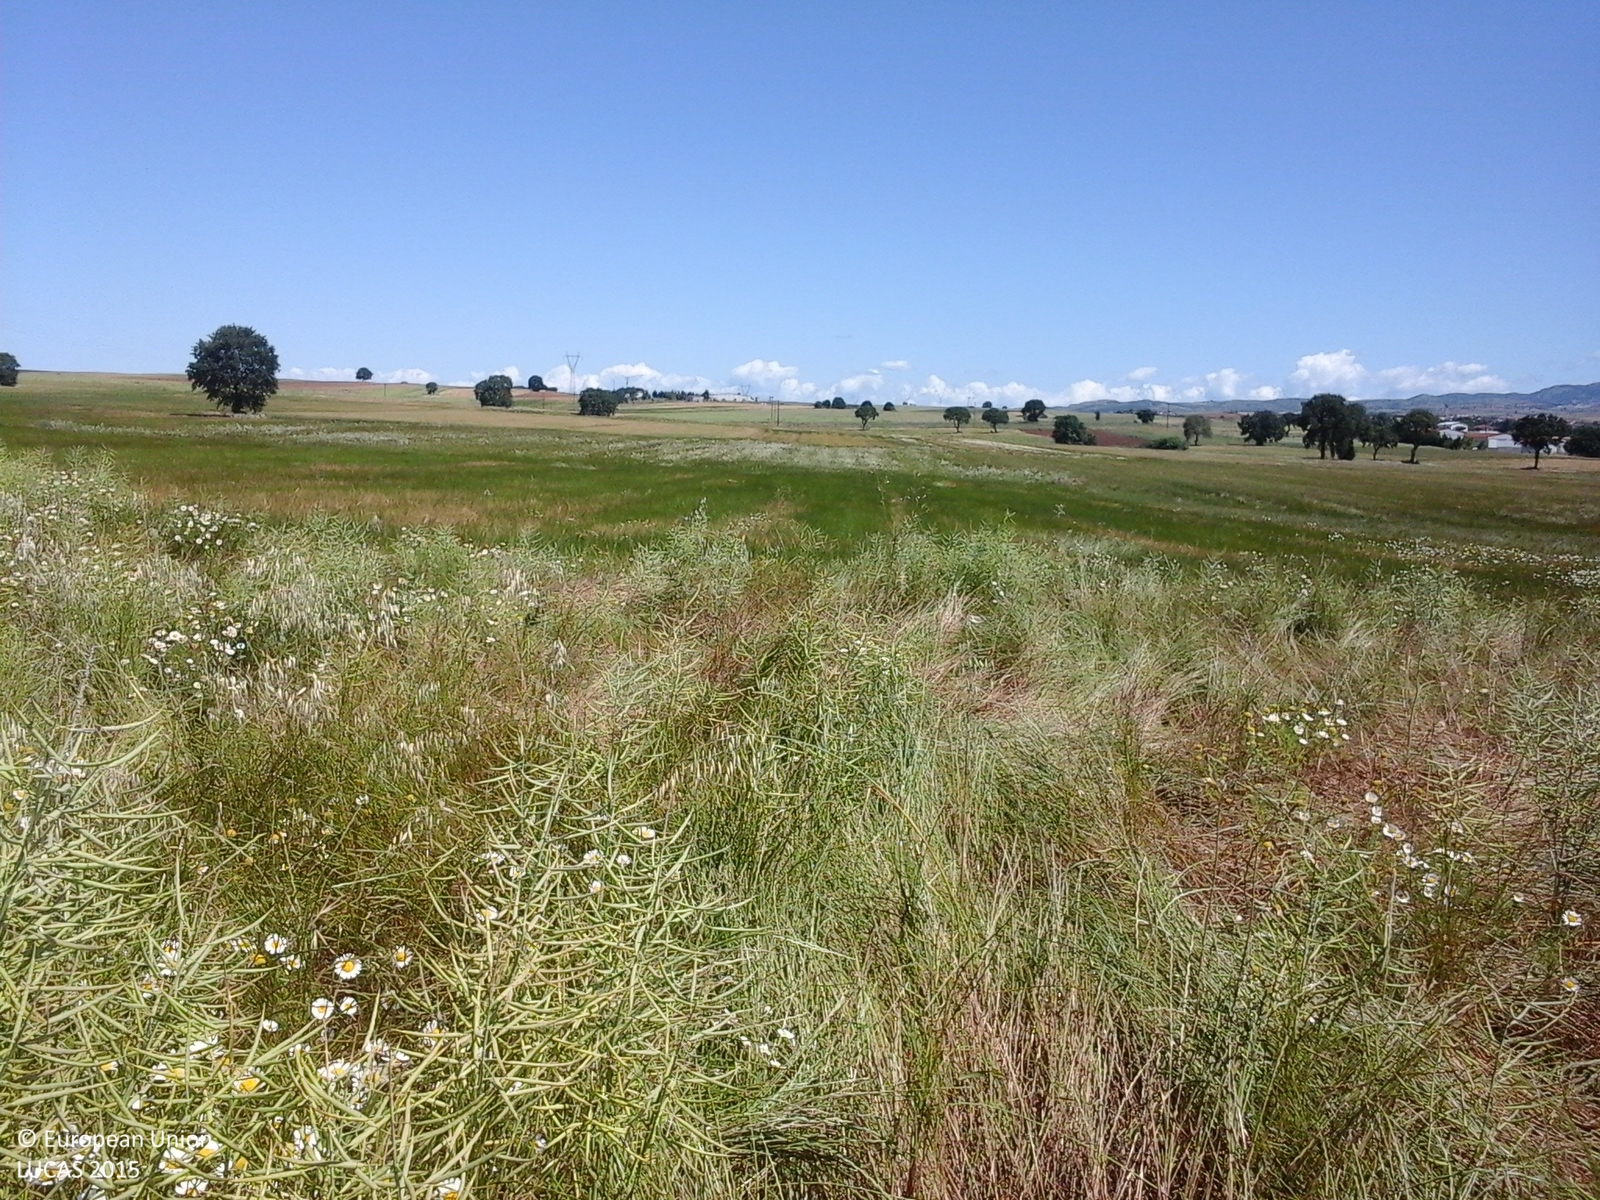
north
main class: Cropland
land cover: Rape and turnip rape
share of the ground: > 75 %
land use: Agriculture (excluding fallow land and kitchen gardens)
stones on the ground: < 10 %
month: May
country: GR
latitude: 40.8052
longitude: 23.0134
